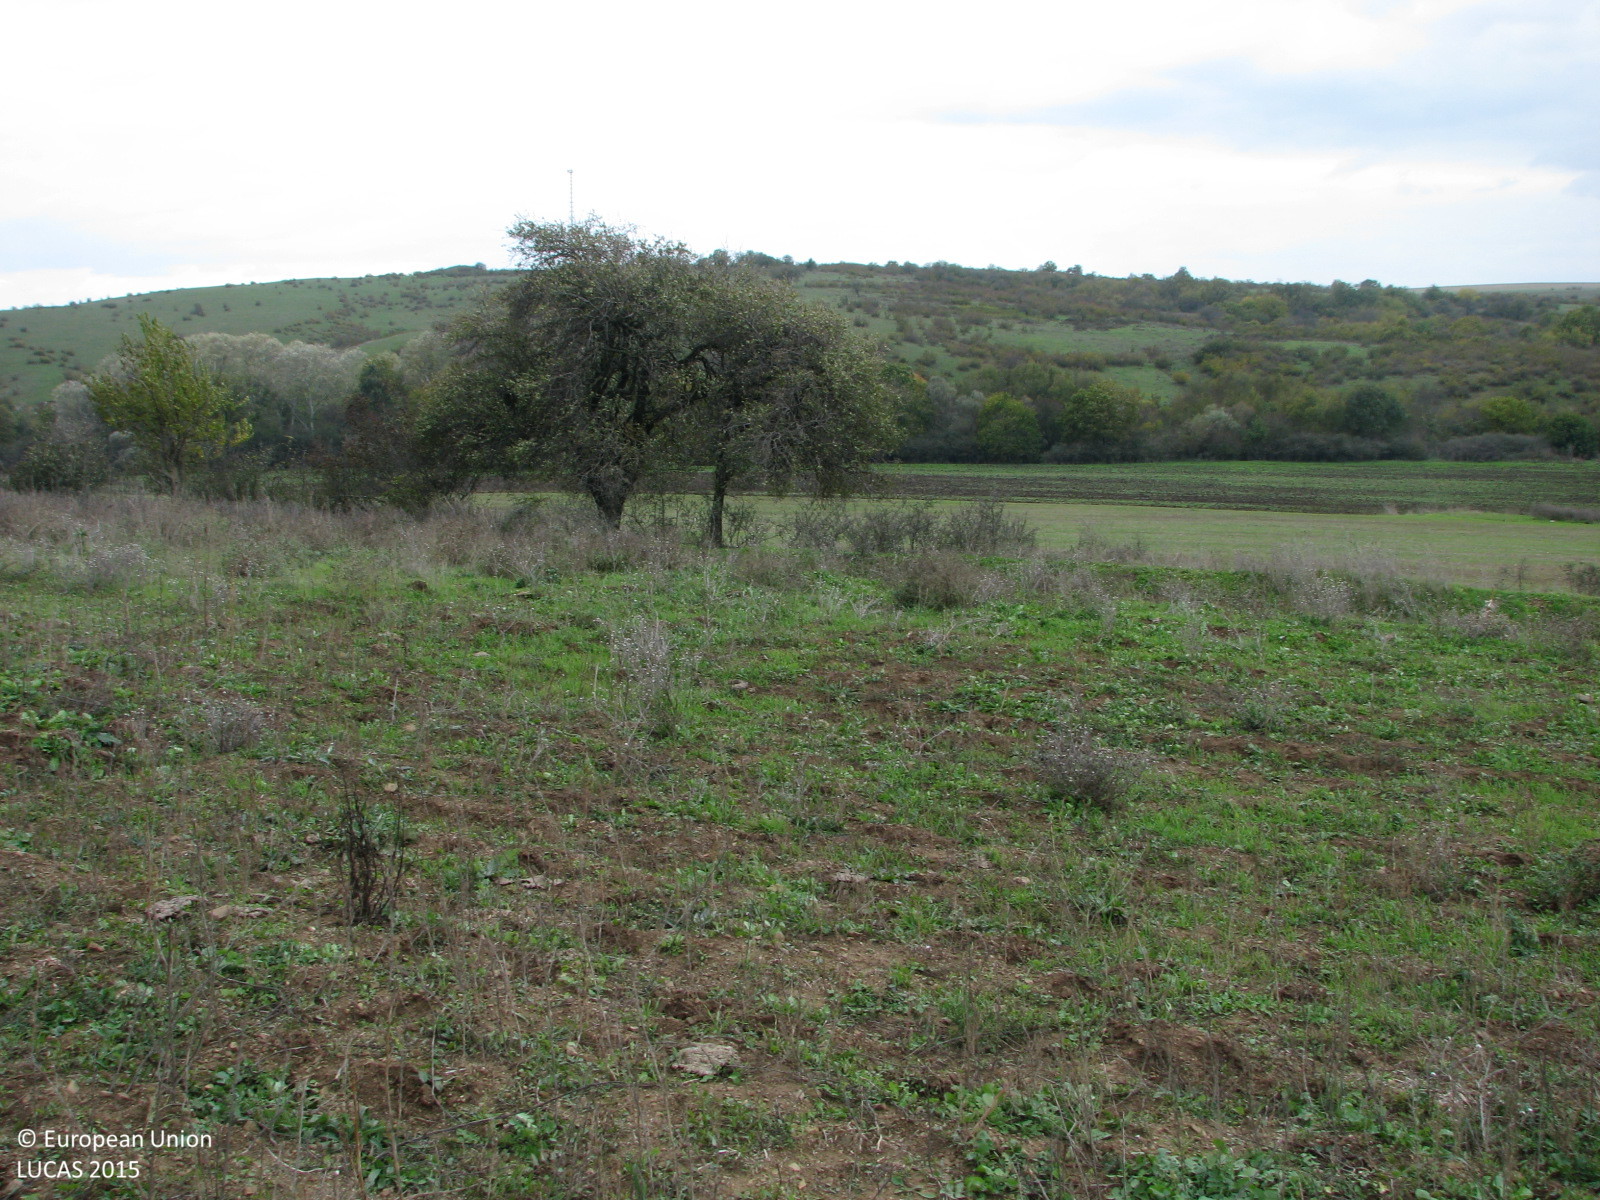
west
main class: Grassland
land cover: Spontaneously vegetated surfaces
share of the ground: 50 - 75 %
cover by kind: herbaceous plants 60 %, unconsolidated bare surface 40 %
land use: Fallow land
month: October
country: BG
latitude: 42.2089
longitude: 26.7243
